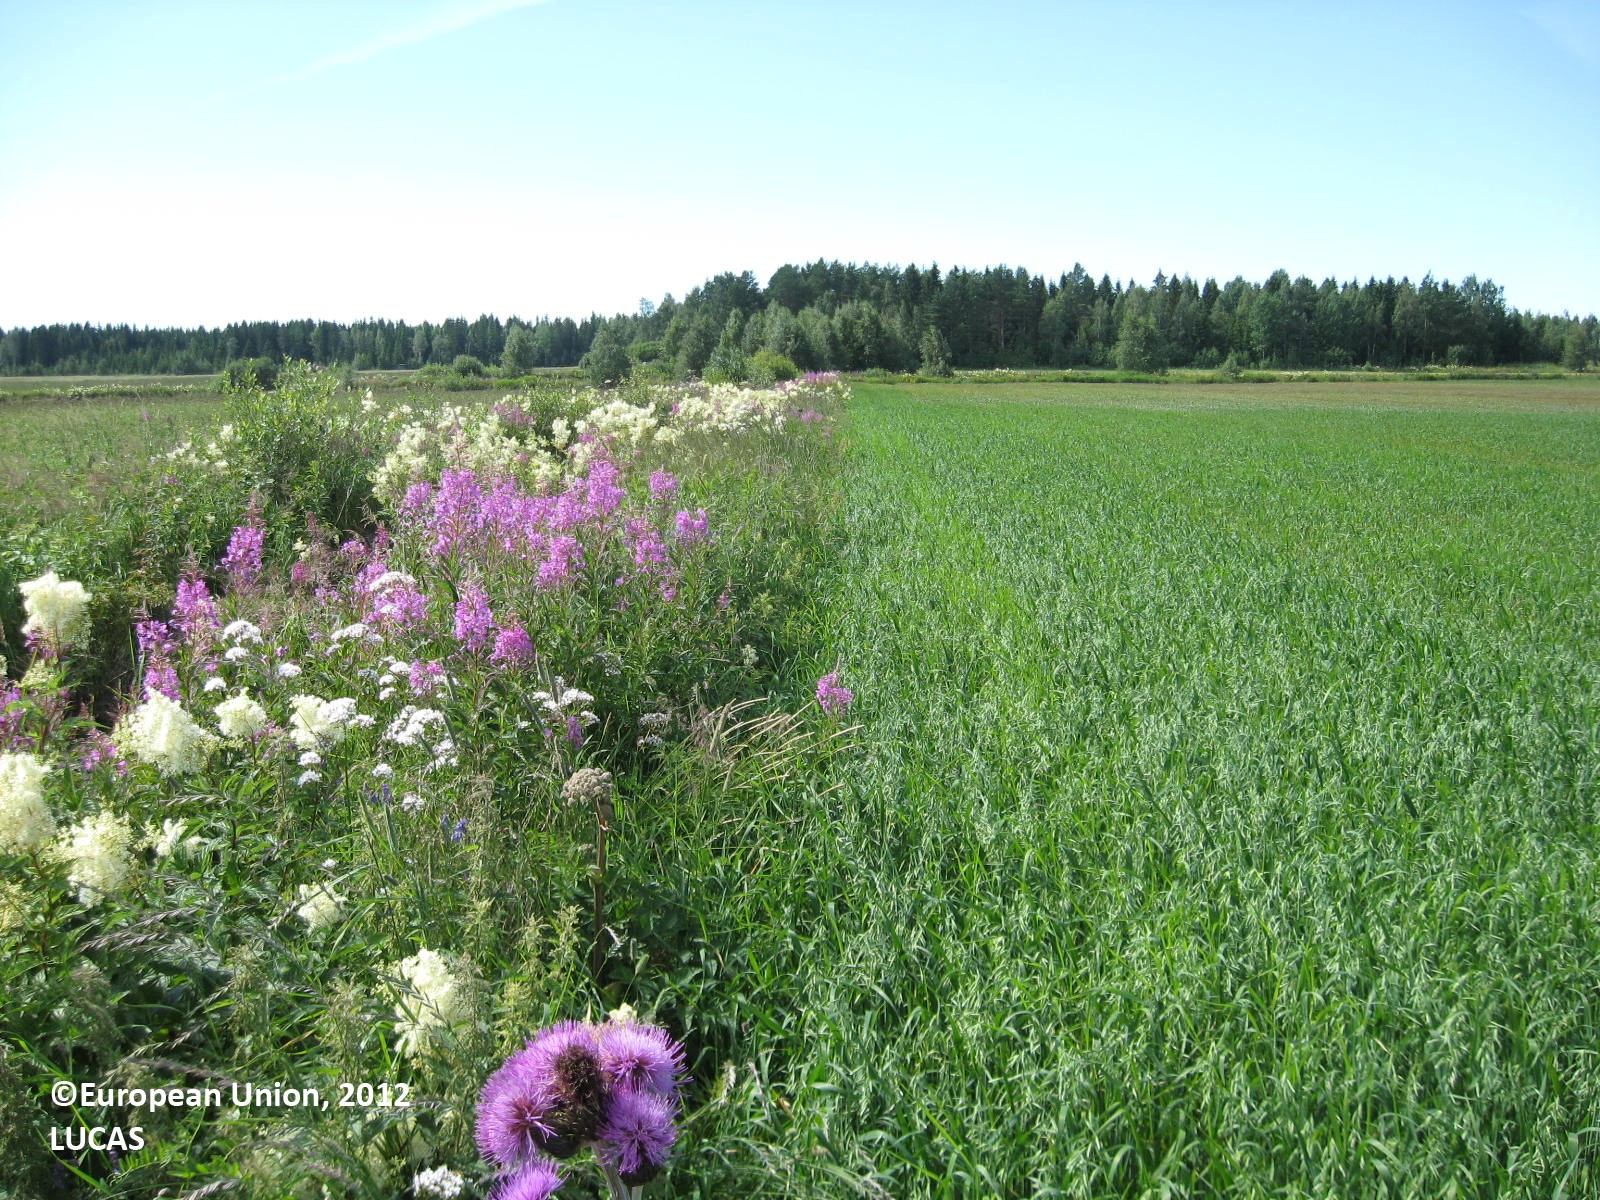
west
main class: Cropland
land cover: Oats
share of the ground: > 75 %
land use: Agriculture (excluding fallow land and kitchen gardens)
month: July
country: FI
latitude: 62.1135
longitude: 21.5264
